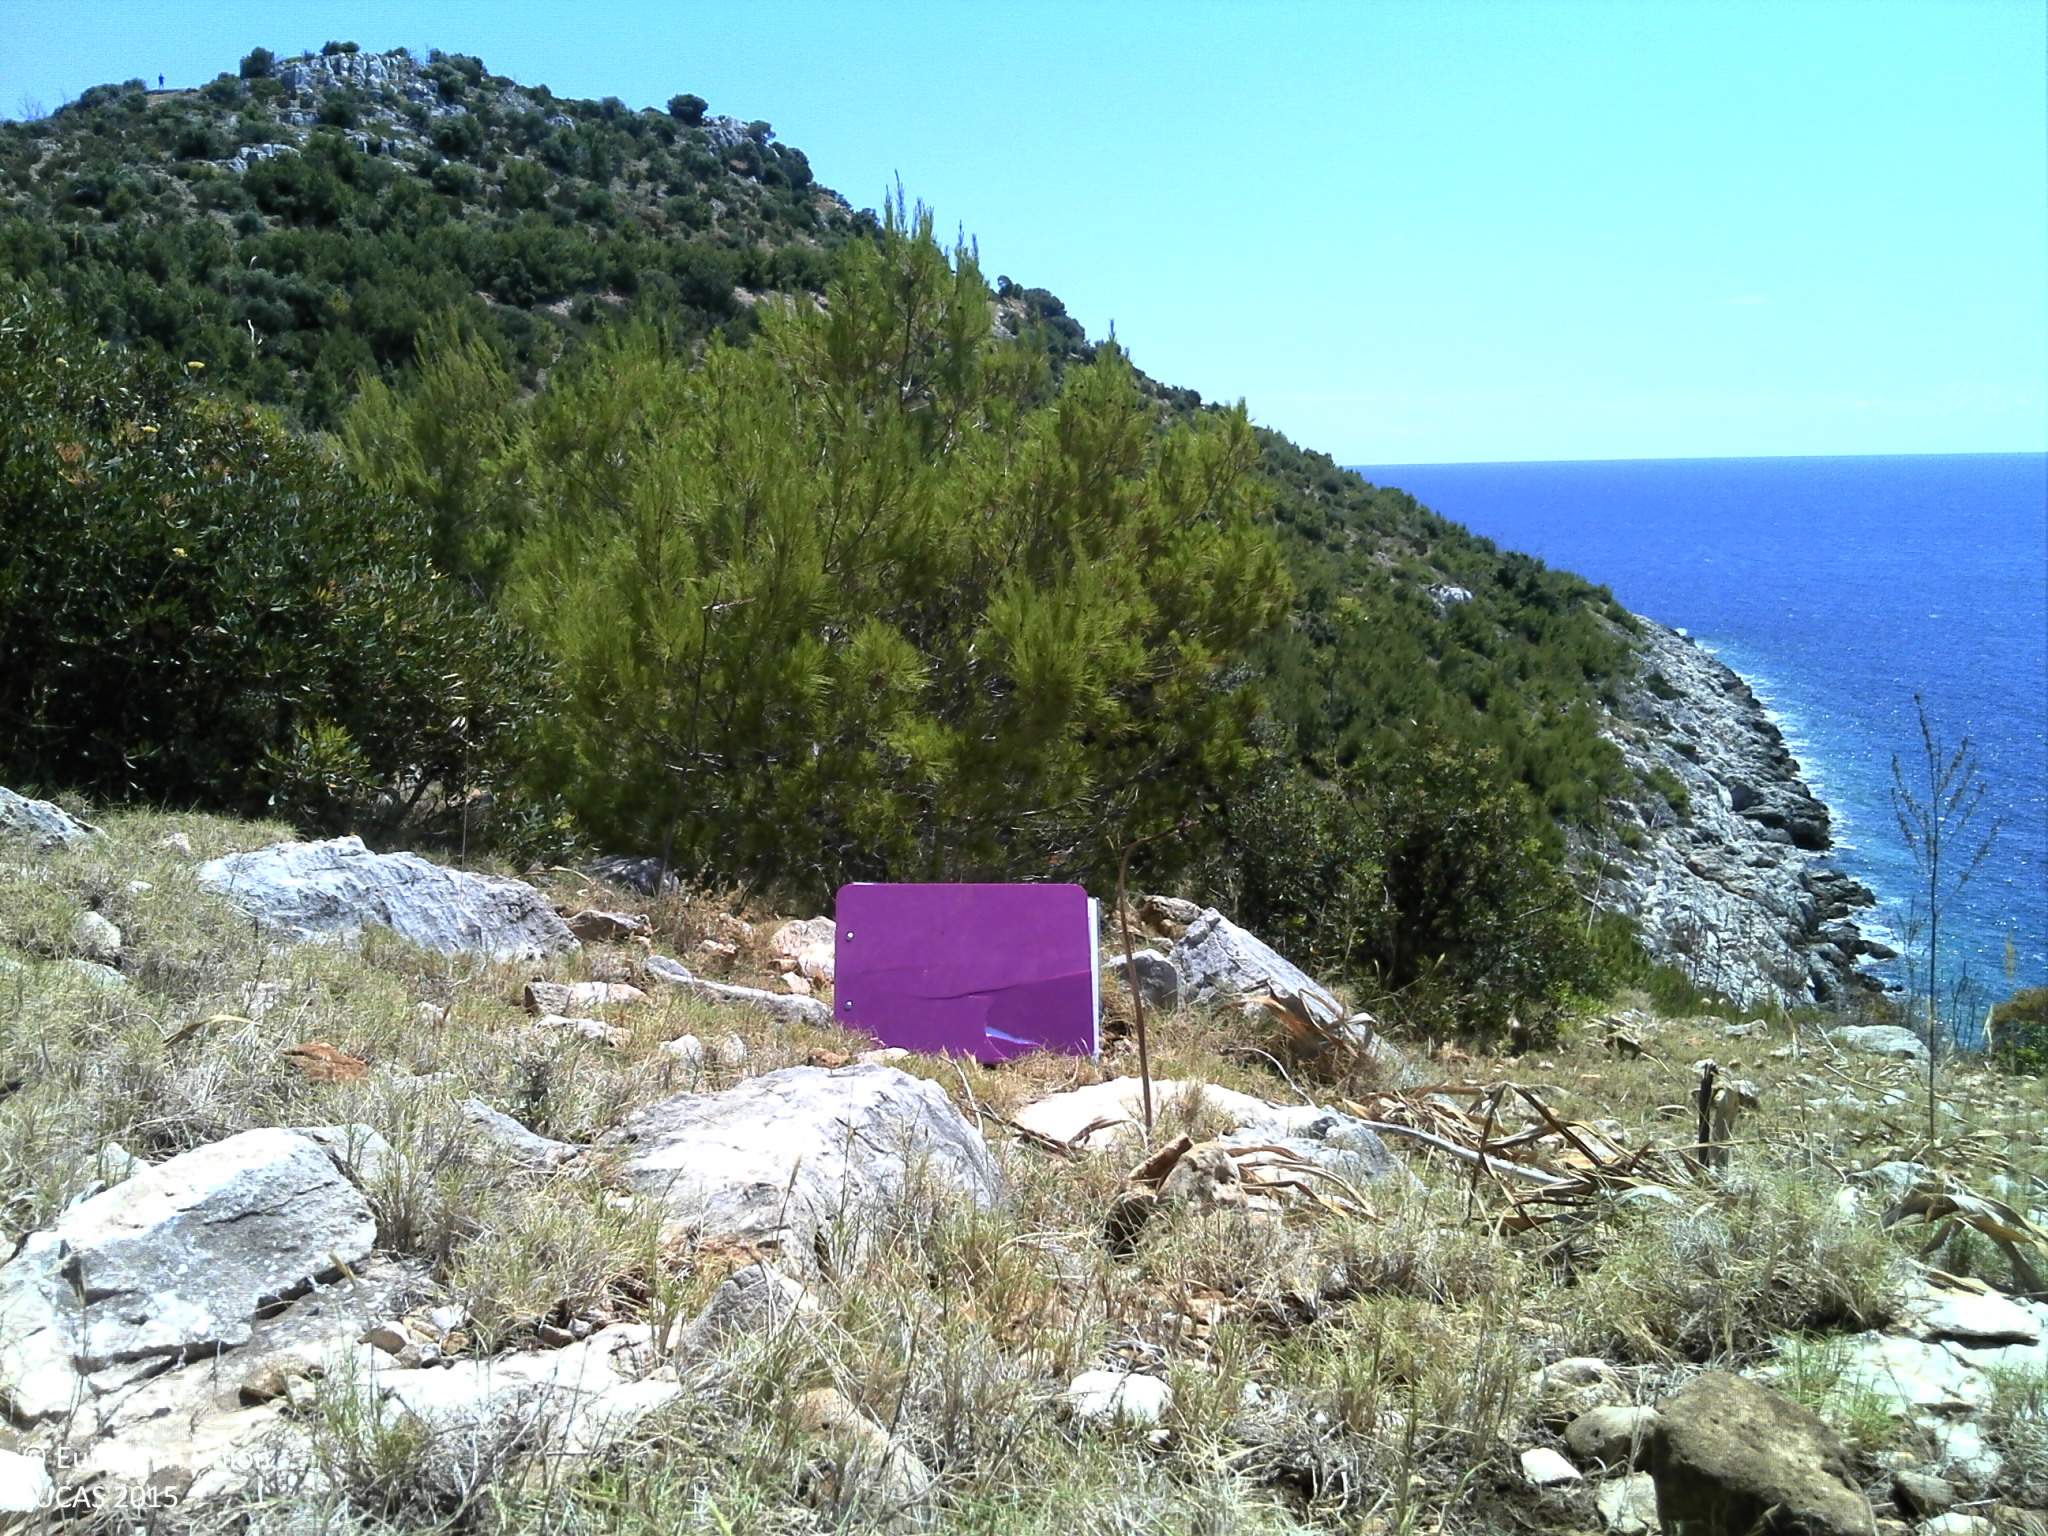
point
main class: Shrubland
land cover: Shrubland without tree cover
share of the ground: 50 - 75 %
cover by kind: shrubs 50 %, unconsolidated bare surface 25 %, consolidated bare surface 15 %, herbaceous plants 10 %
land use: Semi-natural and natural areas not in use
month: June
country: HR
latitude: 42.7307
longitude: 16.8396
